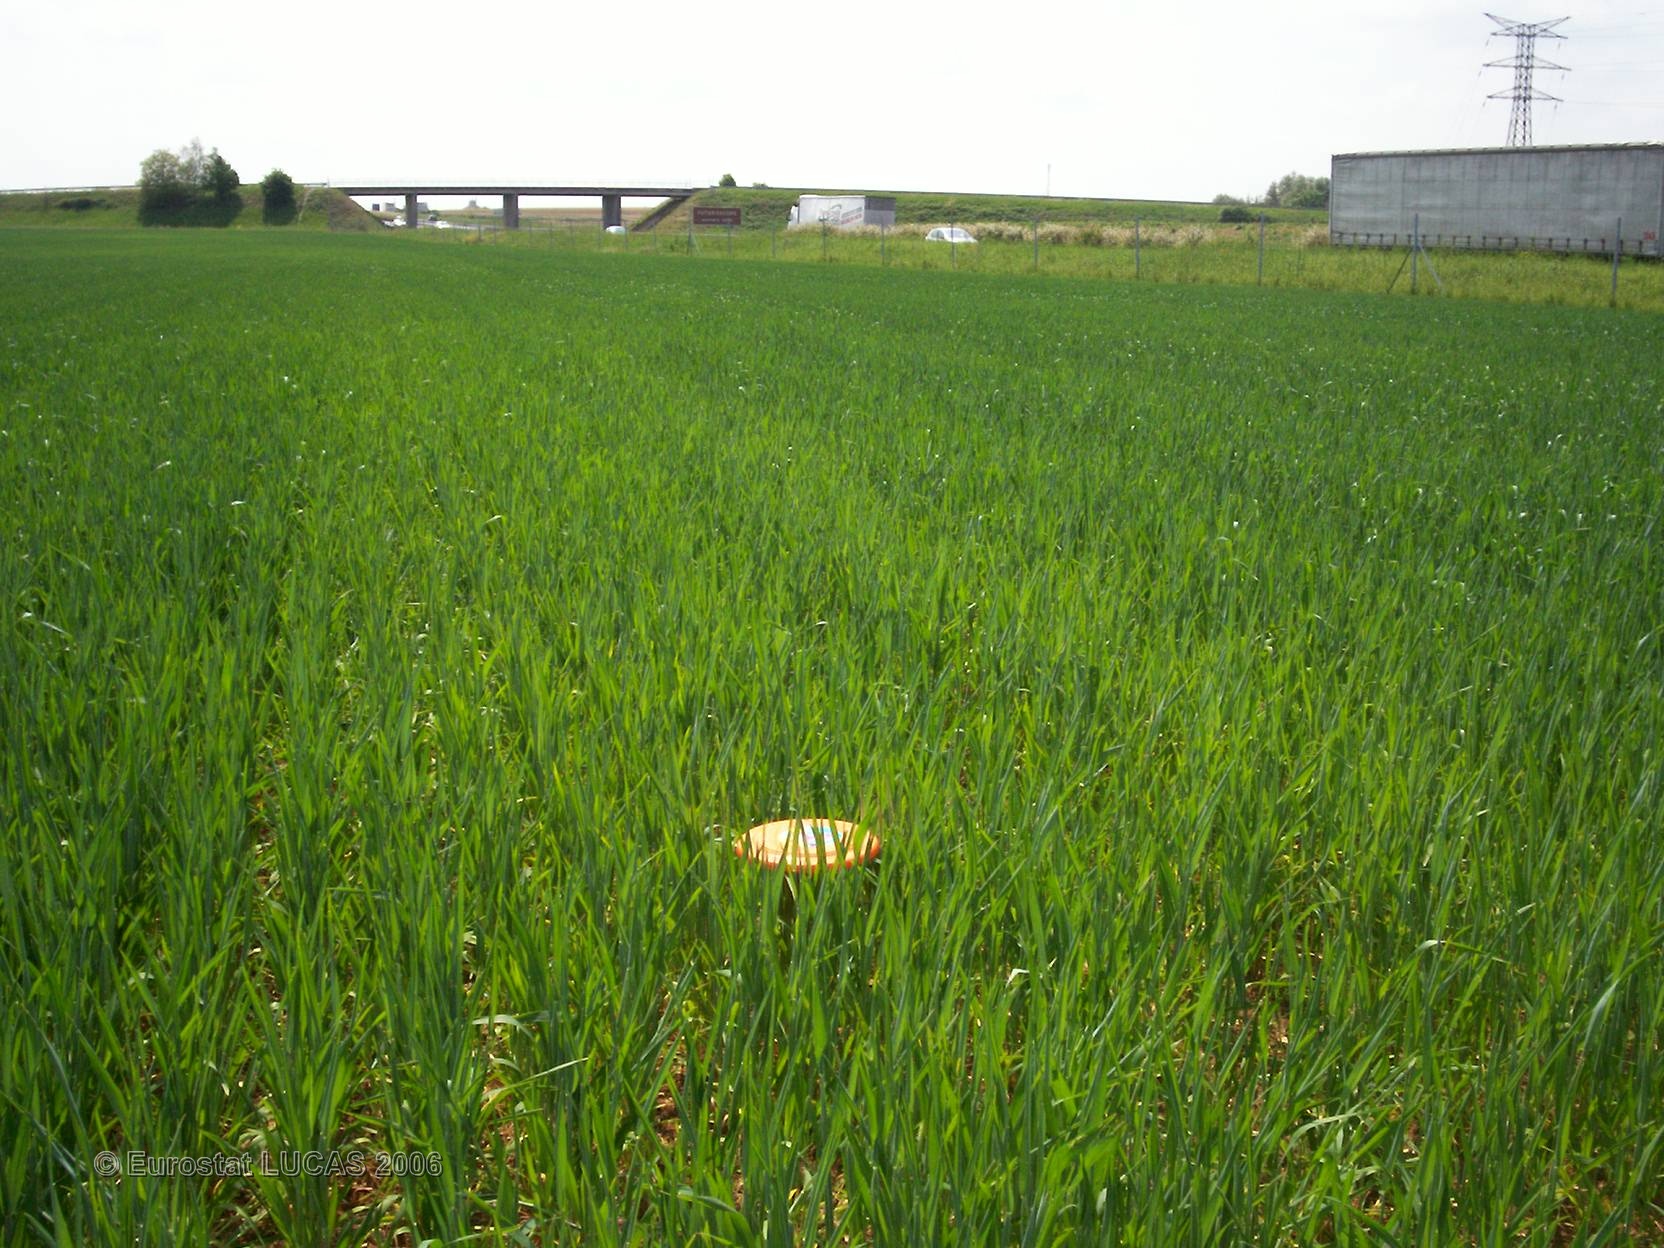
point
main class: Cropland
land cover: Common wheat
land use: Agriculture (excluding fallow land and kitchen gardens)
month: May
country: FR
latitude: 46.6953
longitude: 0.3690
